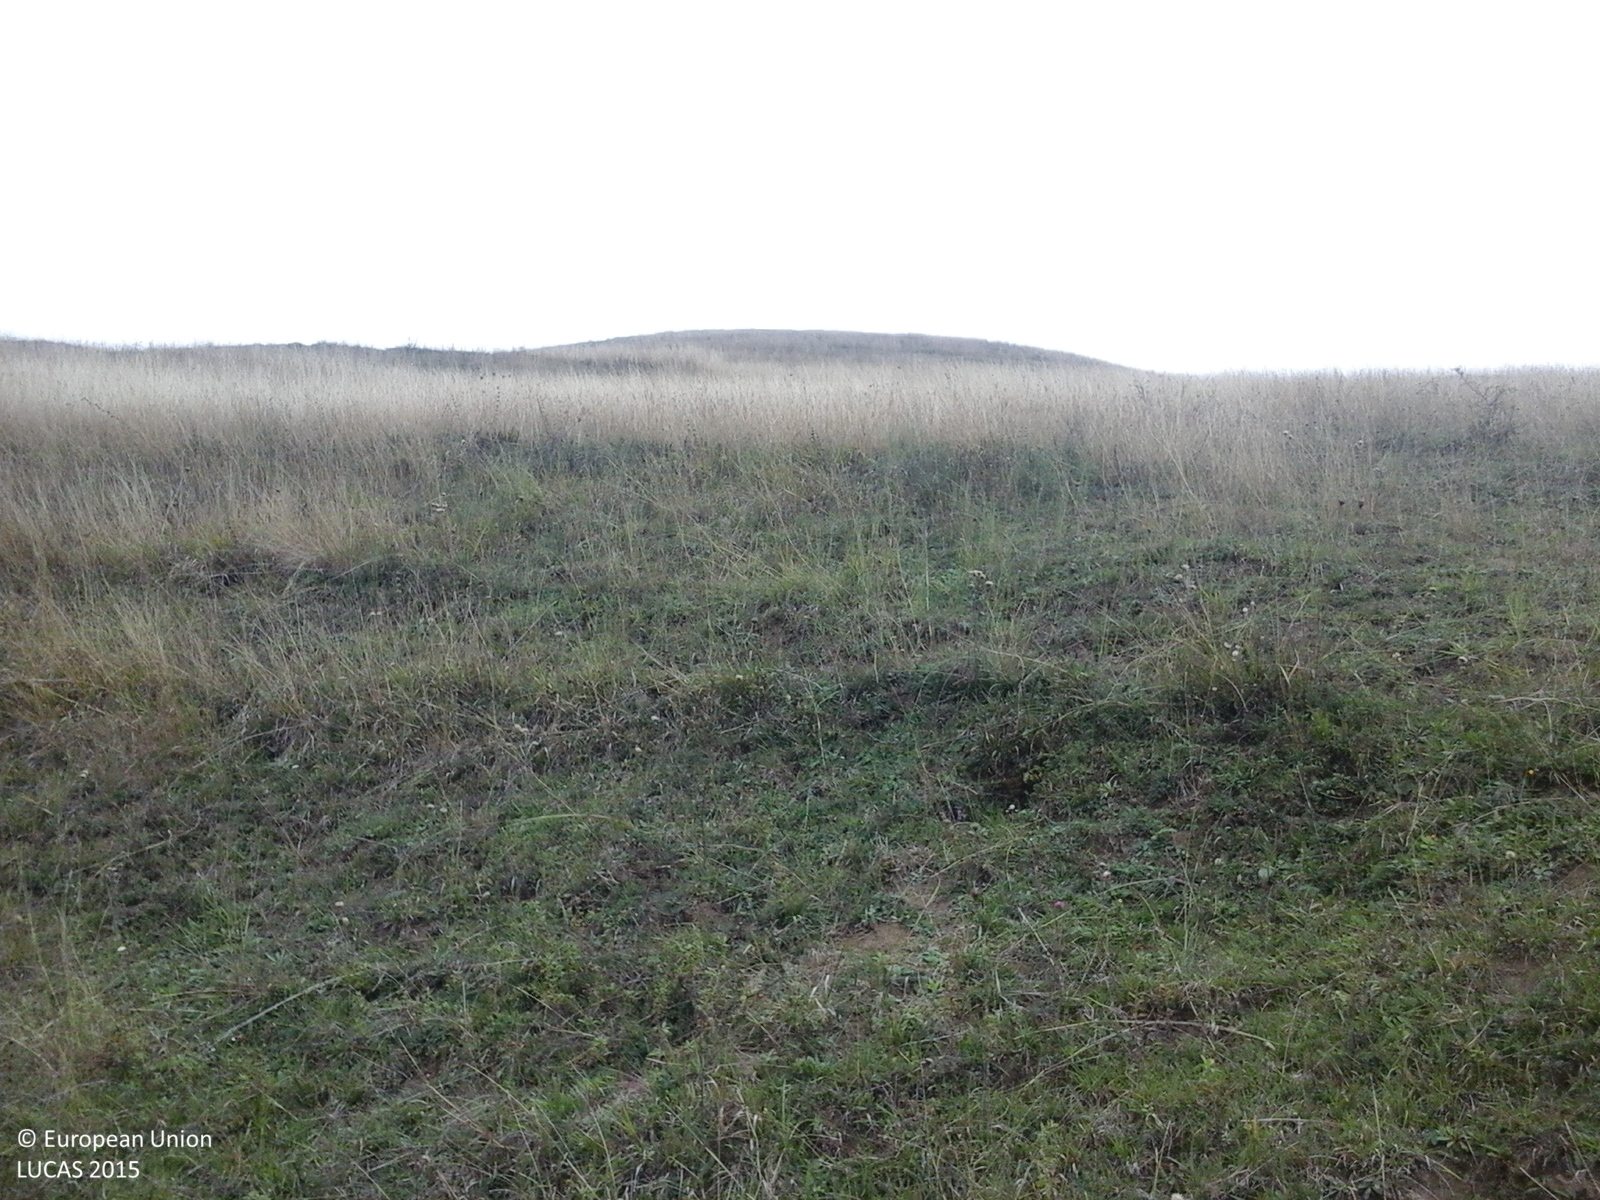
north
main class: Grassland
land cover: Grassland without tree/shrub cover
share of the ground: > 75 %
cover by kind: herbaceous plants 100 %
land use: Agriculture (excluding fallow land and kitchen gardens)
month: October
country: RO
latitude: 46.0453
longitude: 24.8092
